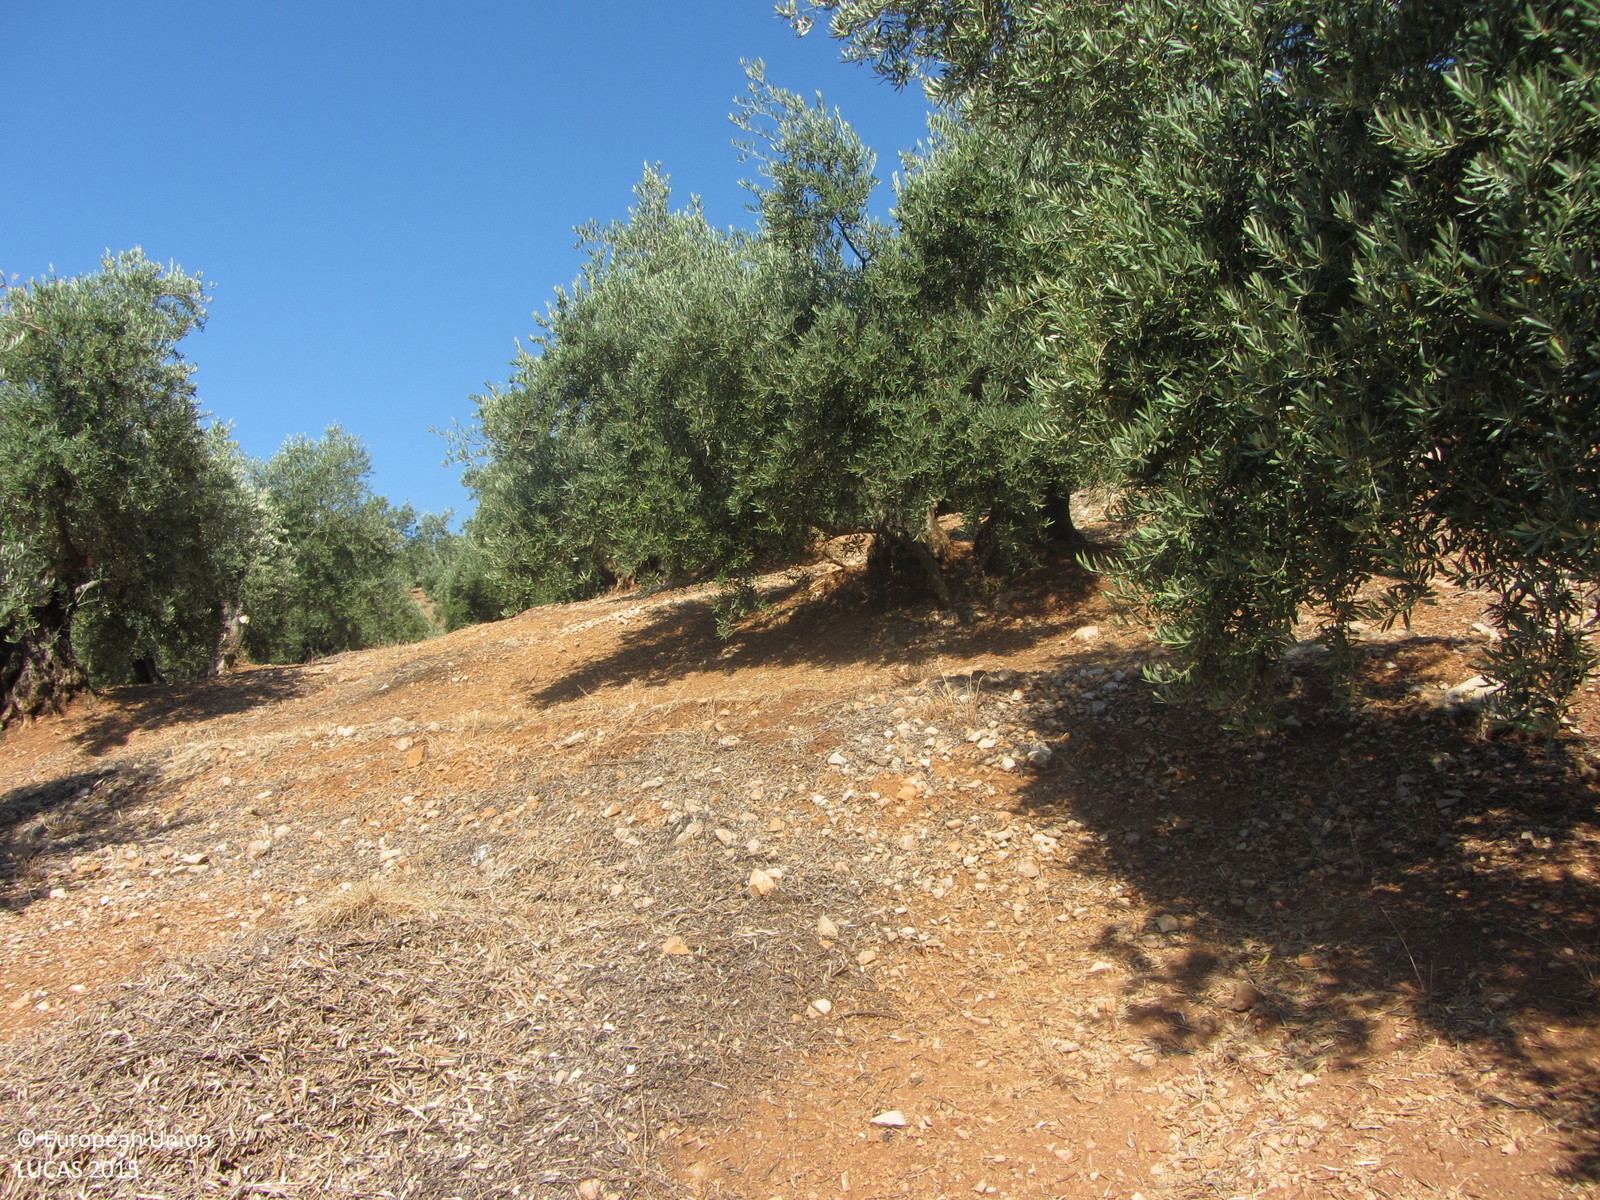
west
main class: Cropland
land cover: Olive groves
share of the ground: 25 - 50 %
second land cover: Other bare soil
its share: > 75 %
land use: Agriculture (excluding fallow land and kitchen gardens)
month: June
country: ES
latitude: 38.2014
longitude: -2.9137
